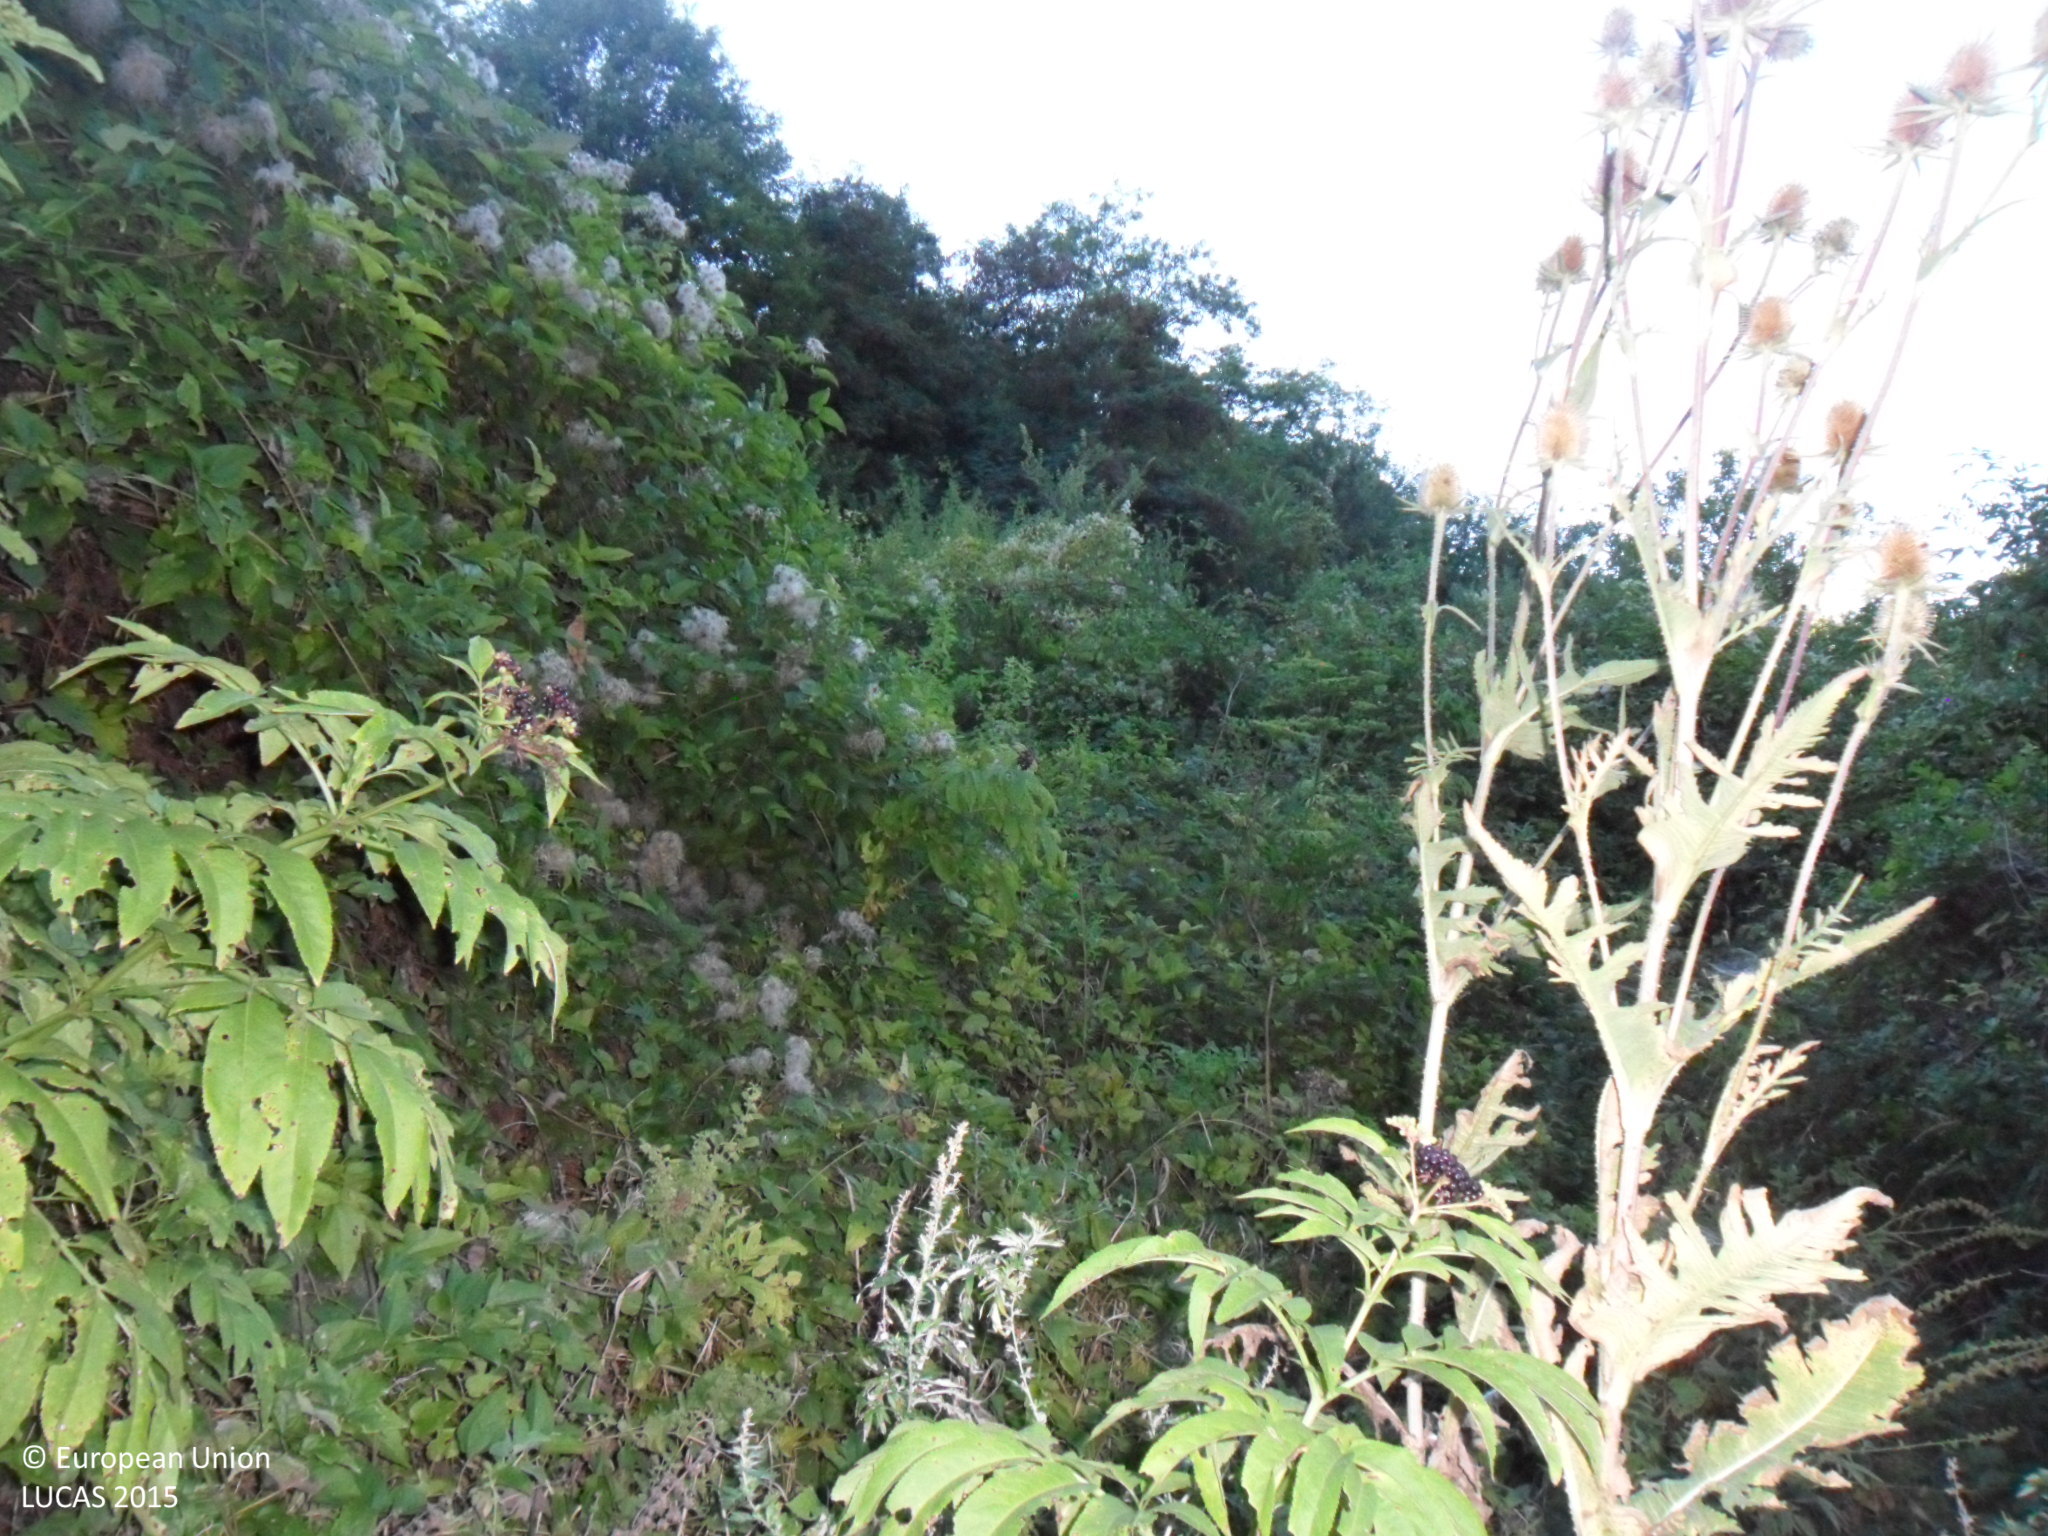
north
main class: Woodland
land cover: Broadleaved woodland
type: mesophytic deciduous forest
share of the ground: 50 - 75 %
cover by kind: broadleaved forest trees 60 %, shrubs 30 %, herbaceous plants 10 %
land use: Forestry
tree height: > 5 m
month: September
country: BG
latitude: 43.1616
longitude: 26.7473
